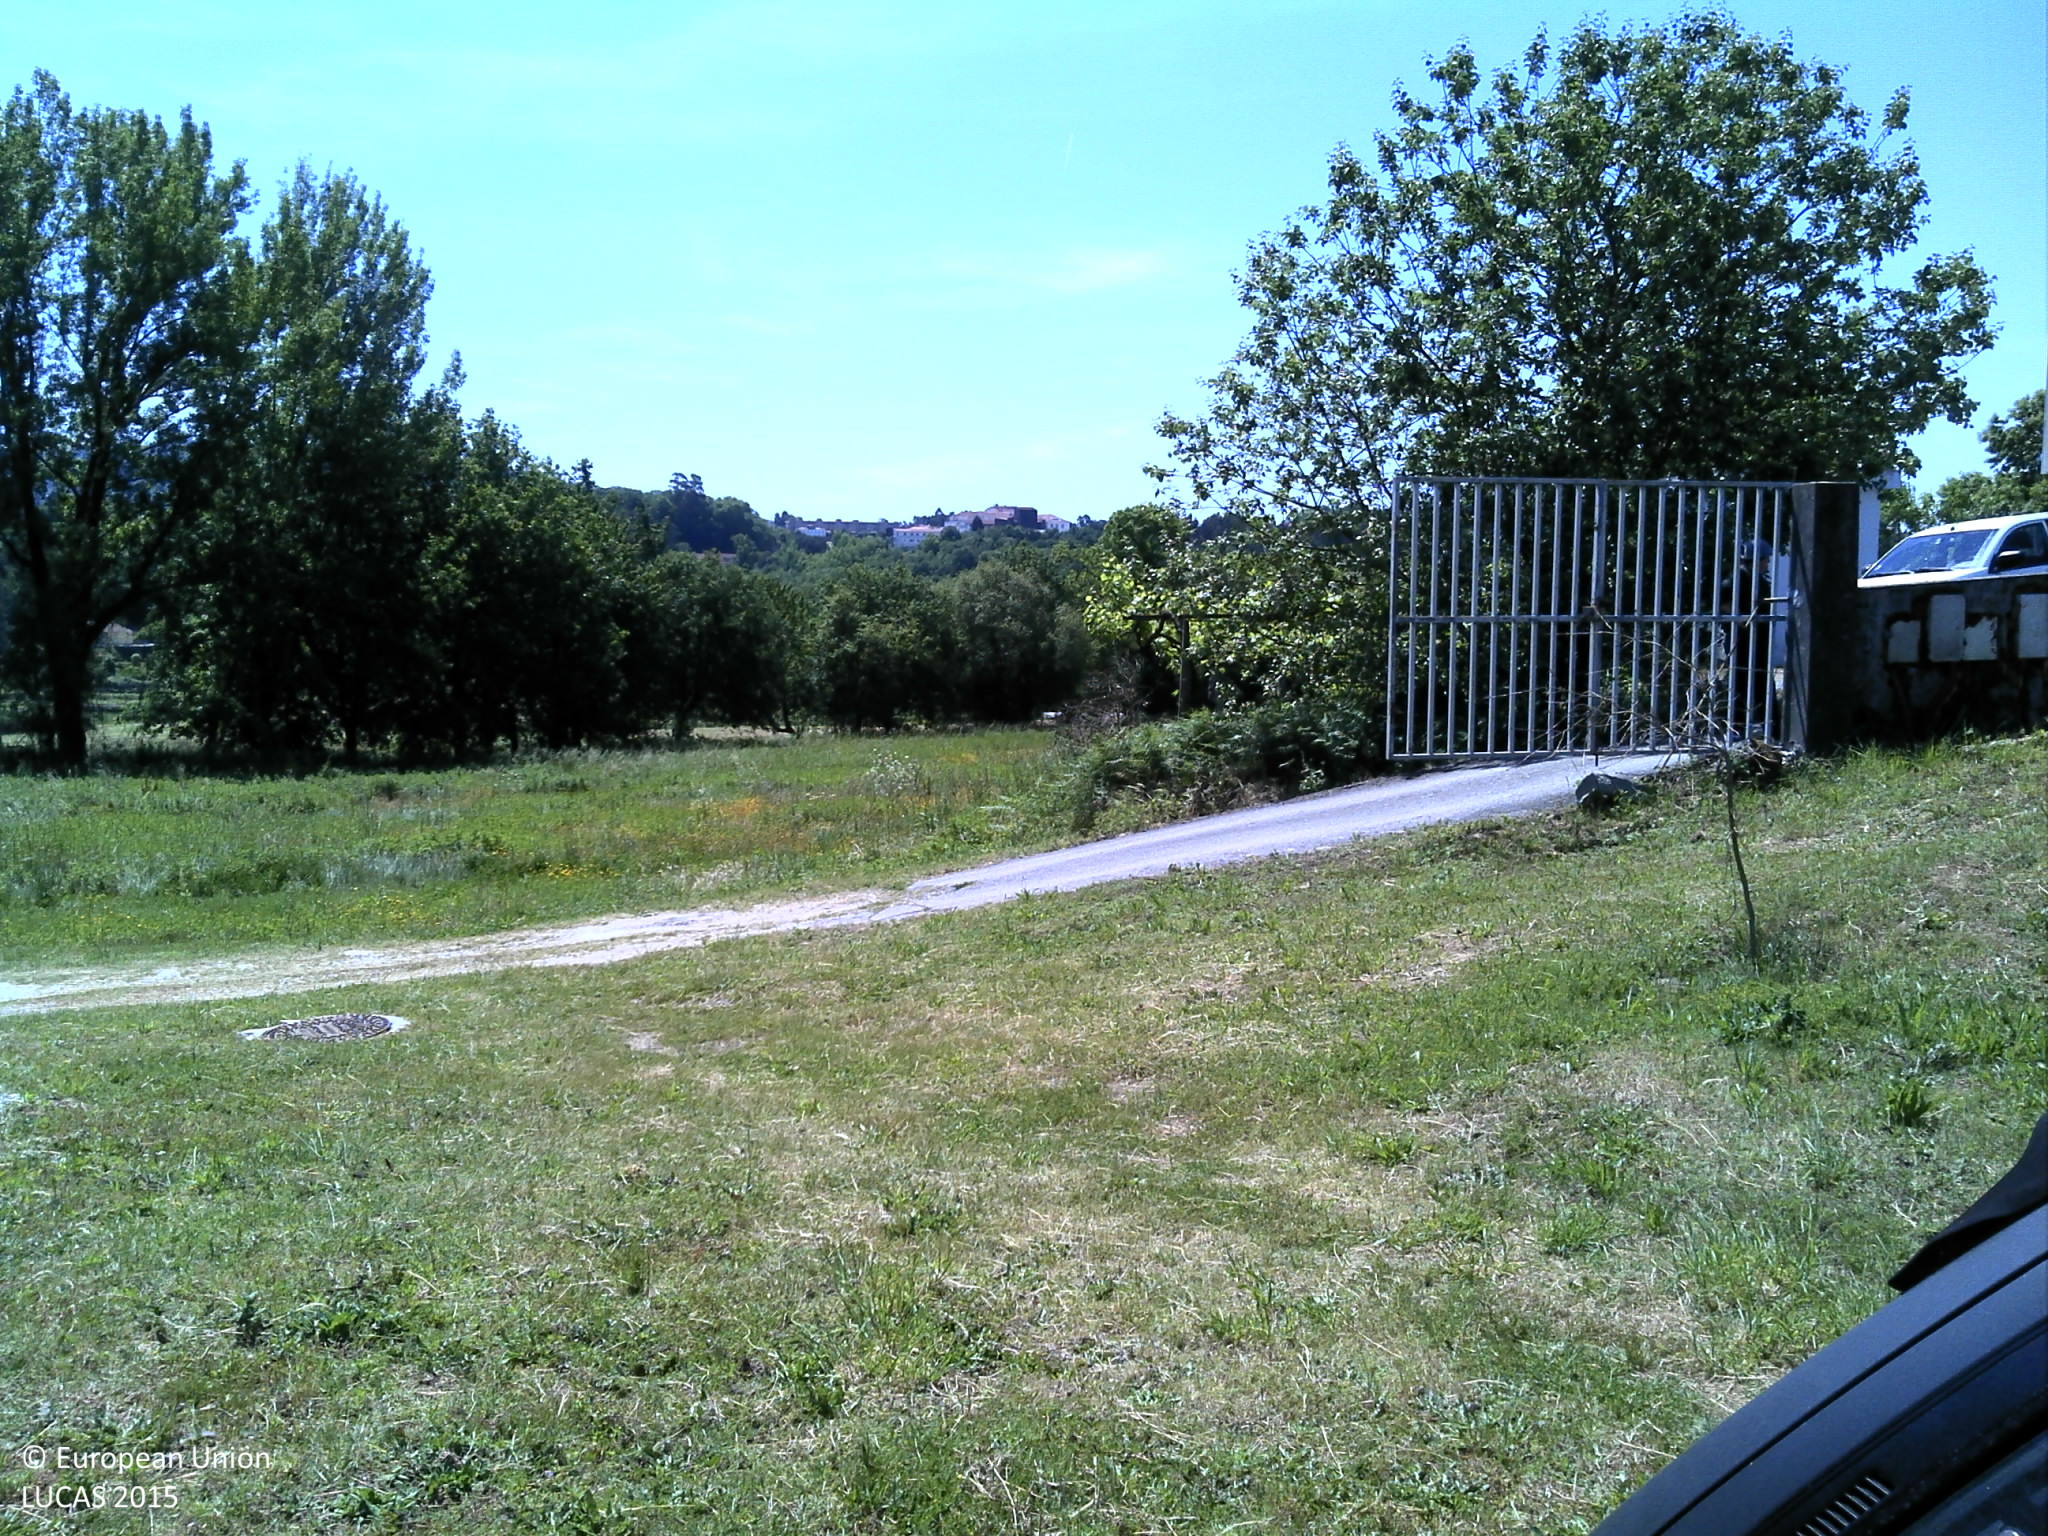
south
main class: Grassland
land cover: Grassland without tree/shrub cover
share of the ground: 50 - 75 %
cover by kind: herbaceous plants 75 %, consolidated bare surface 25 %
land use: Agriculture (excluding fallow land and kitchen gardens)
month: May
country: PT
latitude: 41.3788
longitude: -8.4831
